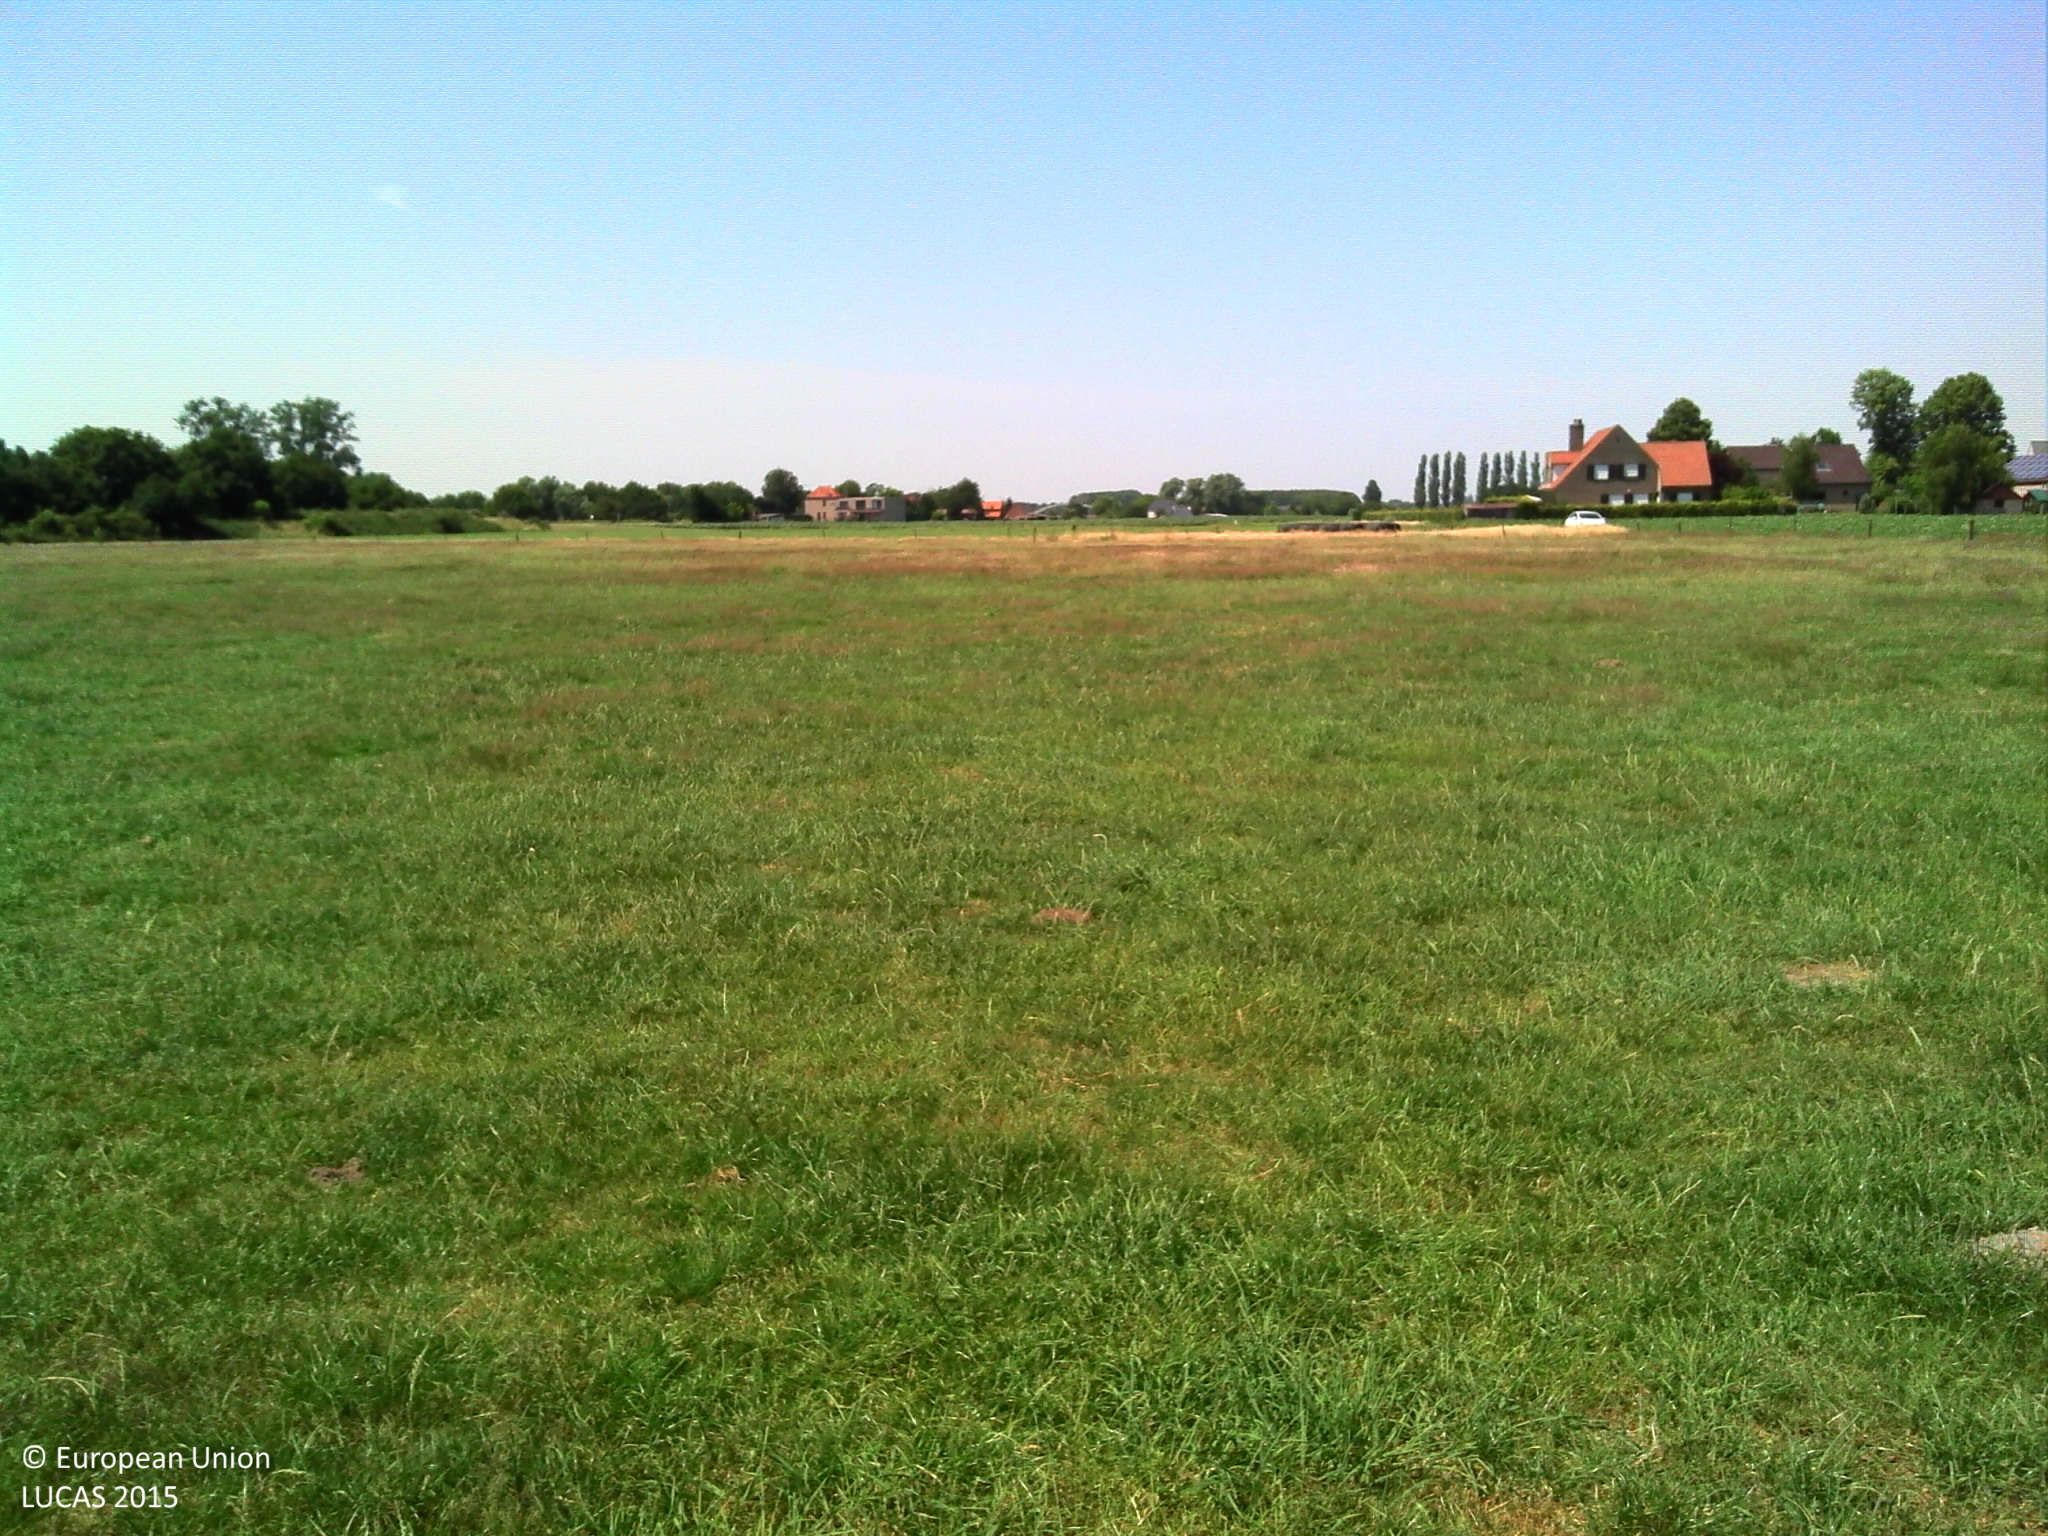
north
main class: Grassland
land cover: Grassland without tree/shrub cover
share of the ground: > 75 %
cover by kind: herbaceous plants 100 %
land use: Agriculture (excluding fallow land and kitchen gardens)
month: July
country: BE
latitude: 51.1119
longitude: 3.4068
